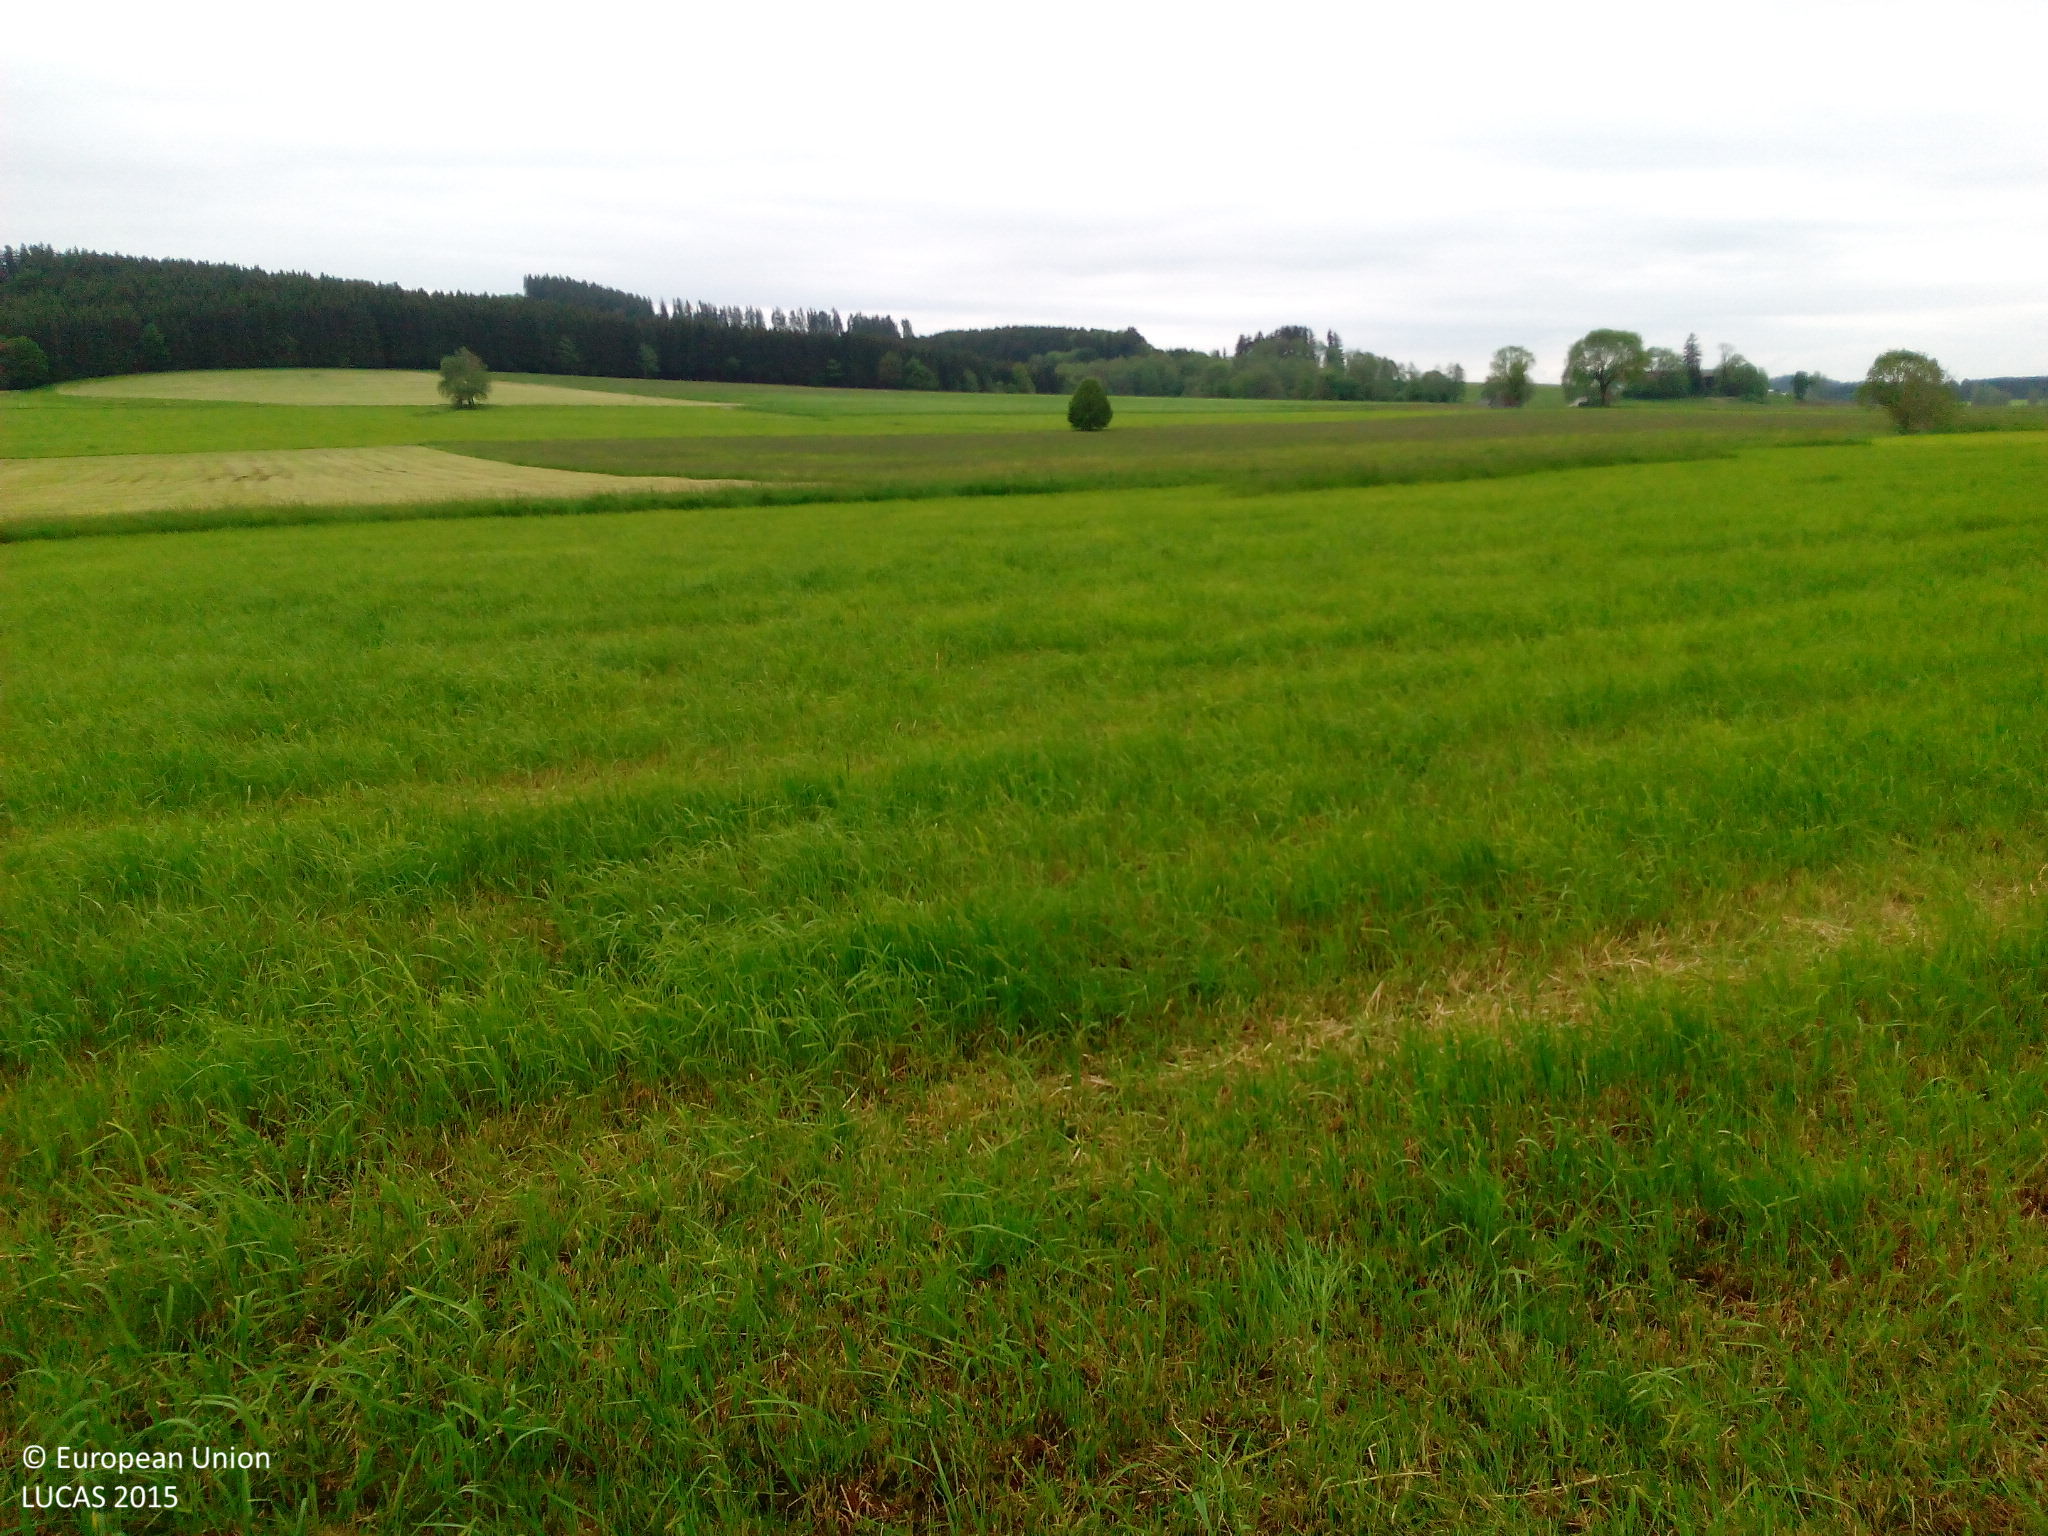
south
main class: Grassland
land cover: Grassland without tree/shrub cover
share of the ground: > 75 %
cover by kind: herbaceous plants 100 %
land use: Agriculture (excluding fallow land and kitchen gardens)
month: May
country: DE
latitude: 47.8816
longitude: 9.9332
